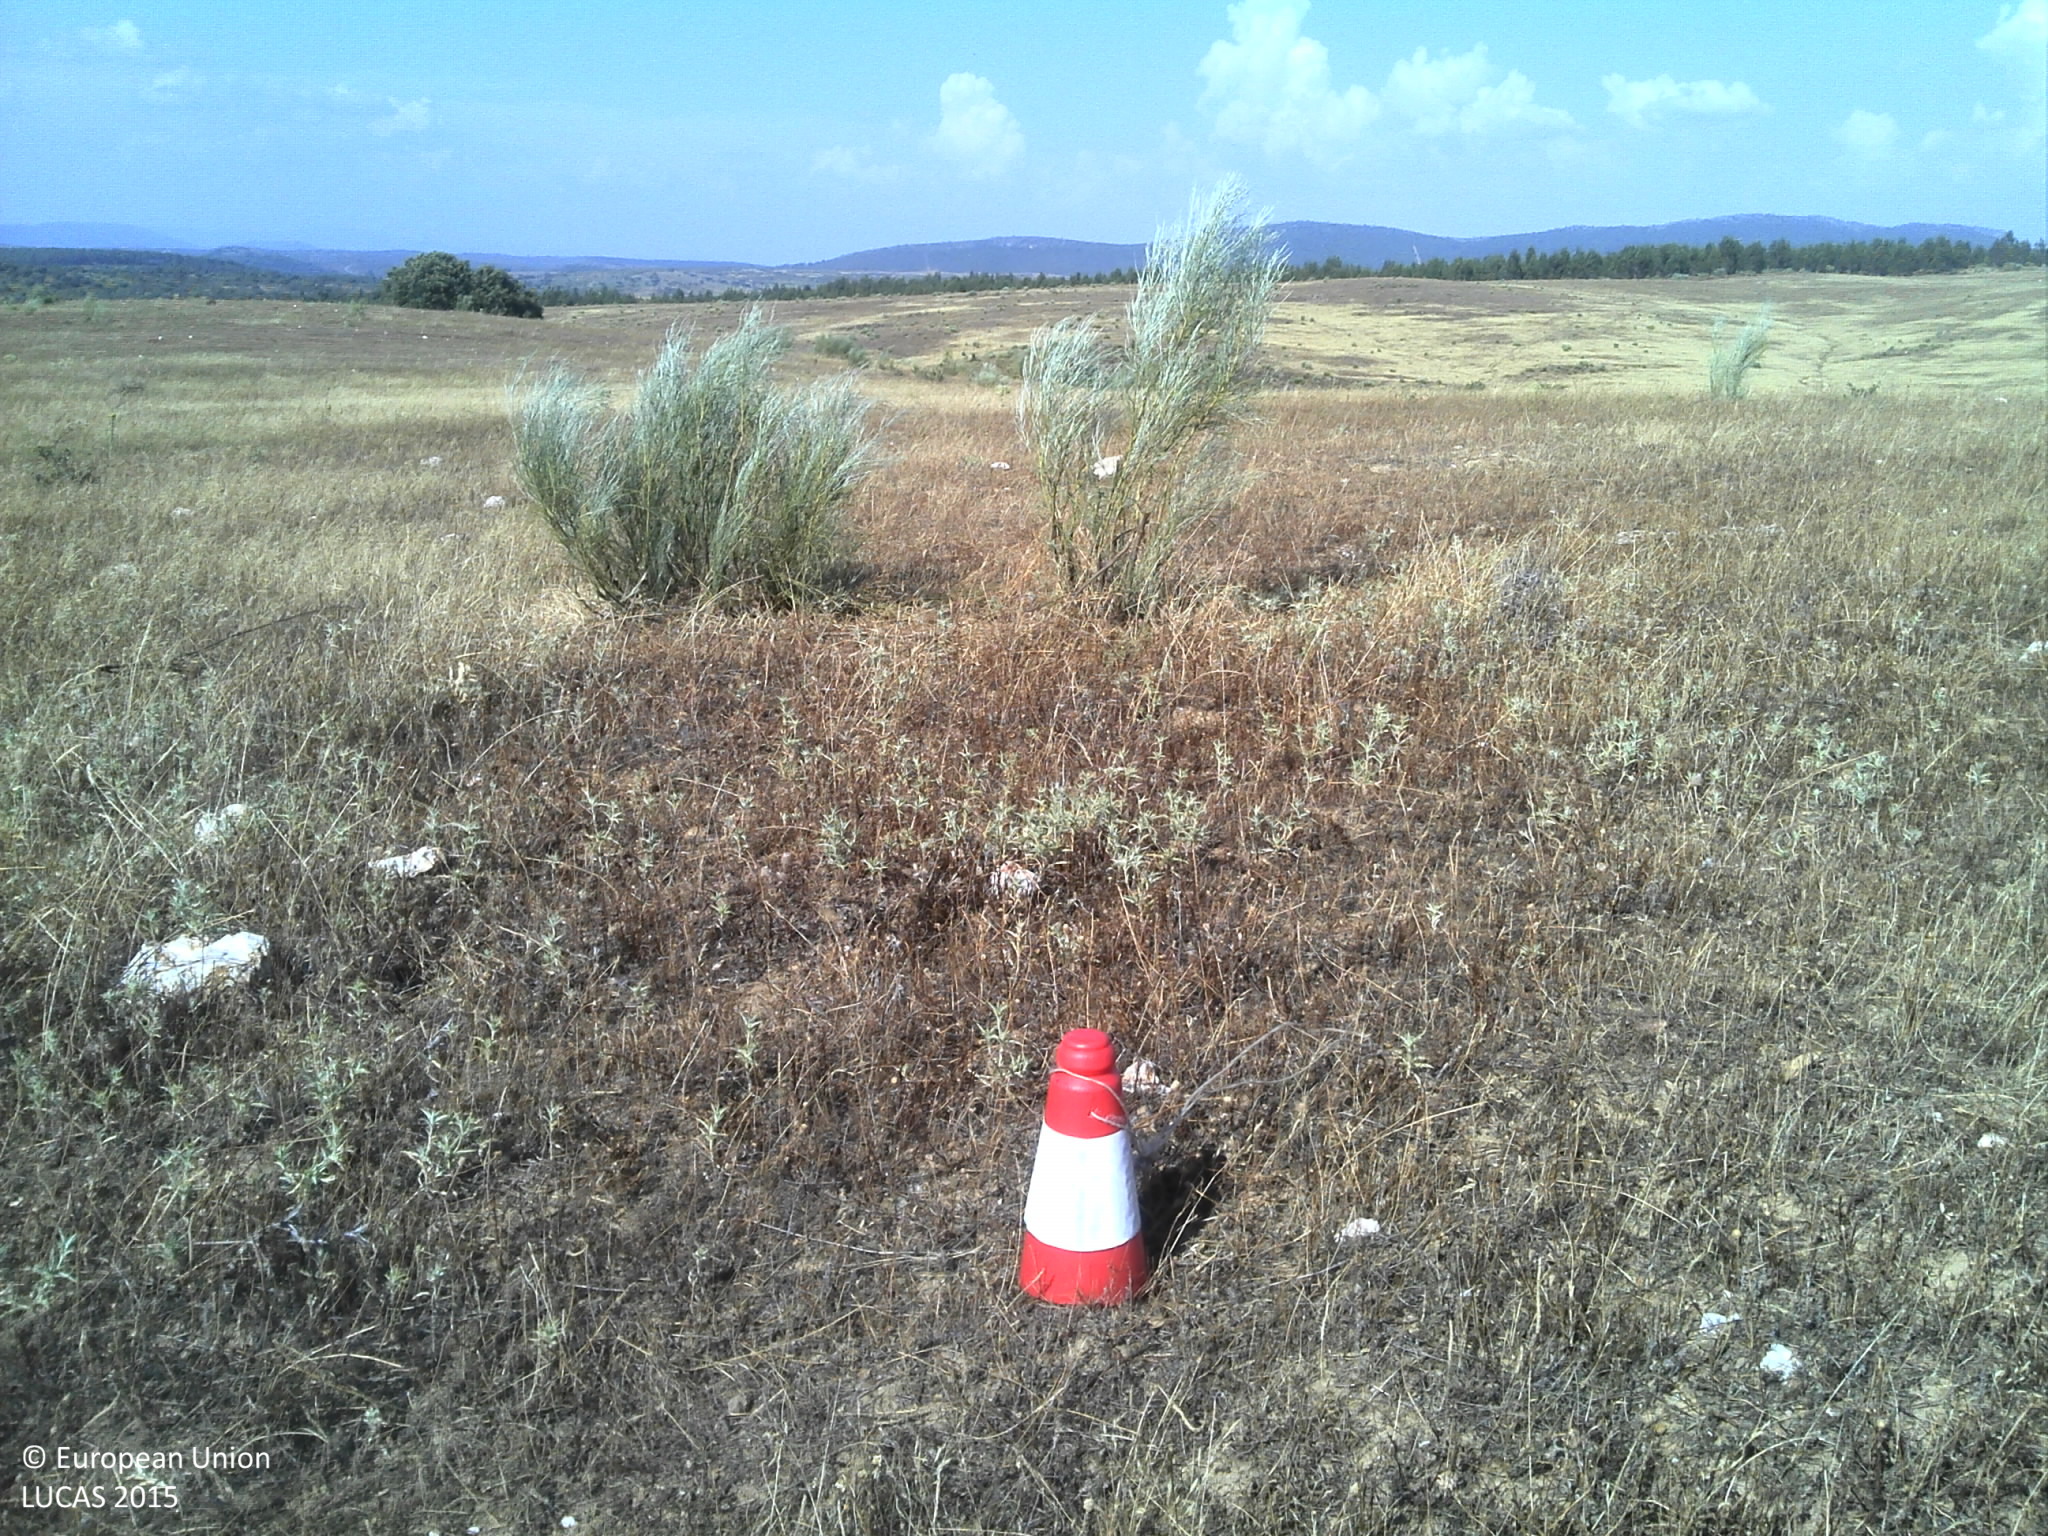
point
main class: Grassland
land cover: Grassland without tree/shrub cover
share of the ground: 25 - 50 %
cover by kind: unconsolidated bare surface 55 %, herbaceous plants 35 %, shrubs 5 %
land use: Agriculture (excluding fallow land and kitchen gardens)
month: June
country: PT
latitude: 39.9494
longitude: -6.9071
